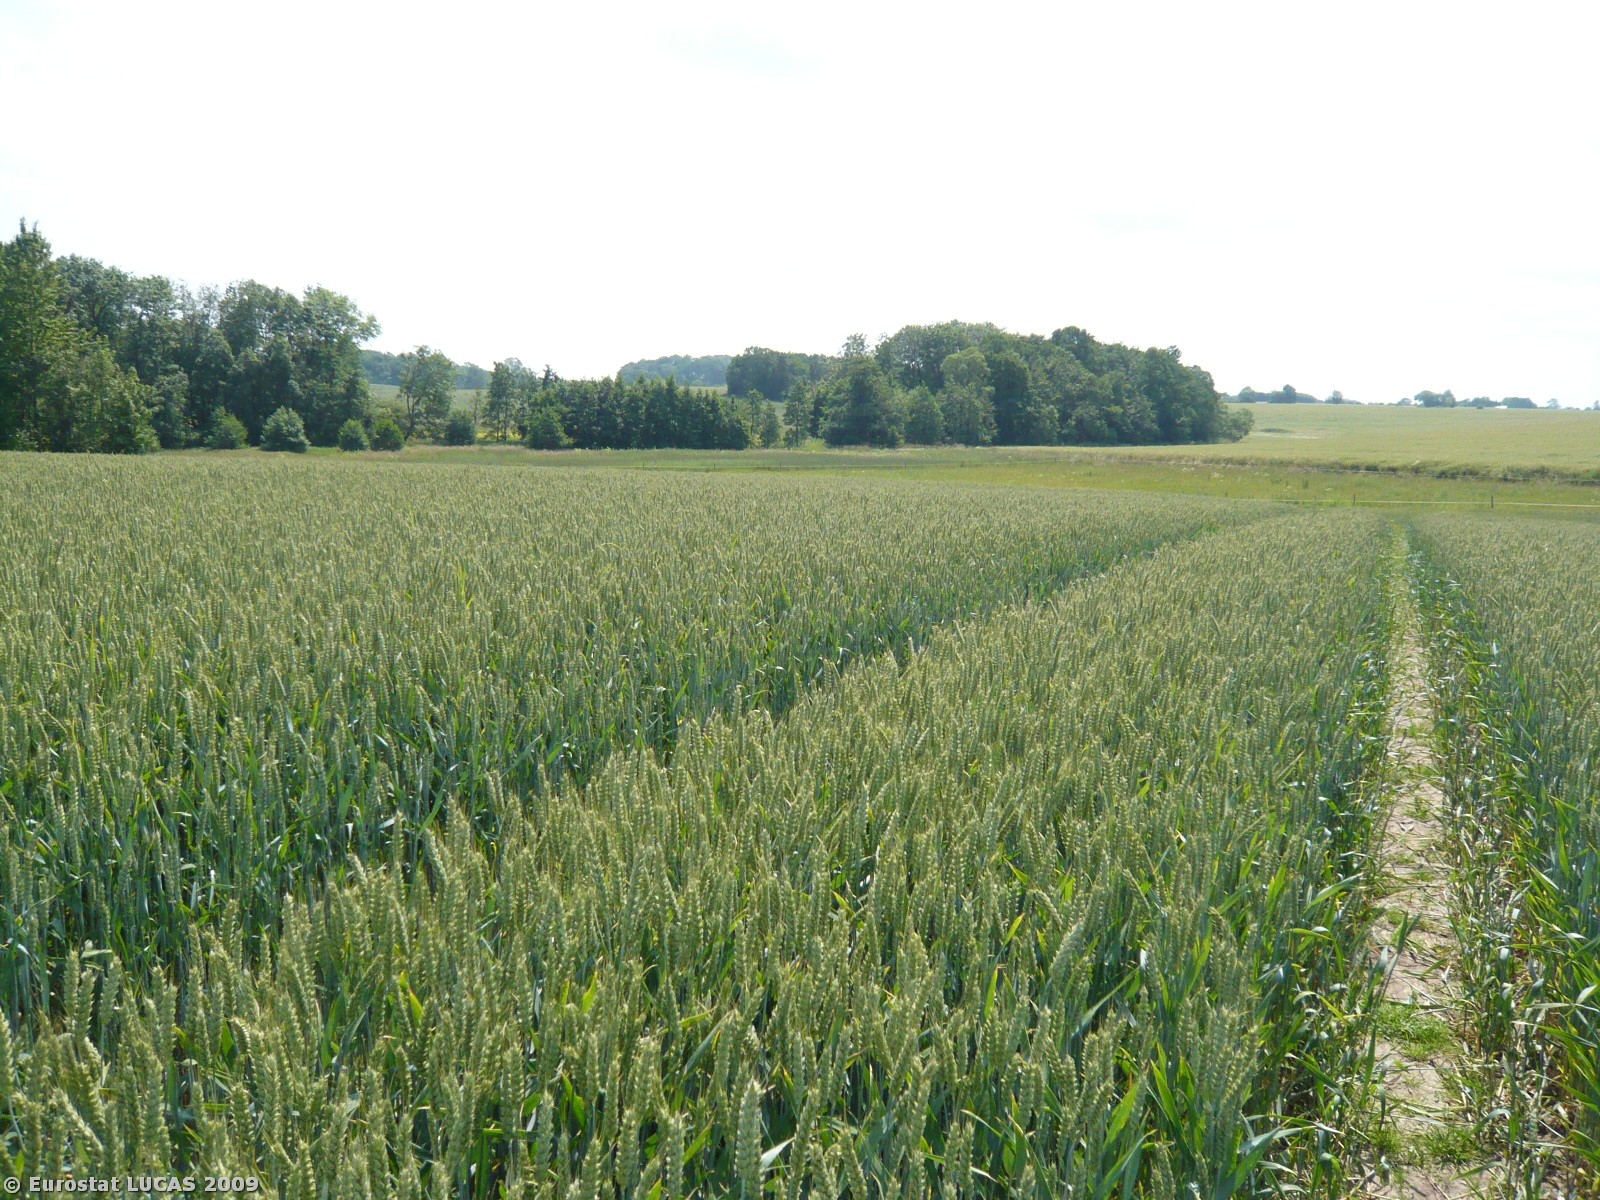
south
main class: Cropland
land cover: Common wheat
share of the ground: > 75 %
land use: Agriculture (excluding fallow land and kitchen gardens)
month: June
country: DK
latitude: 55.2874
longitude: 10.6450
